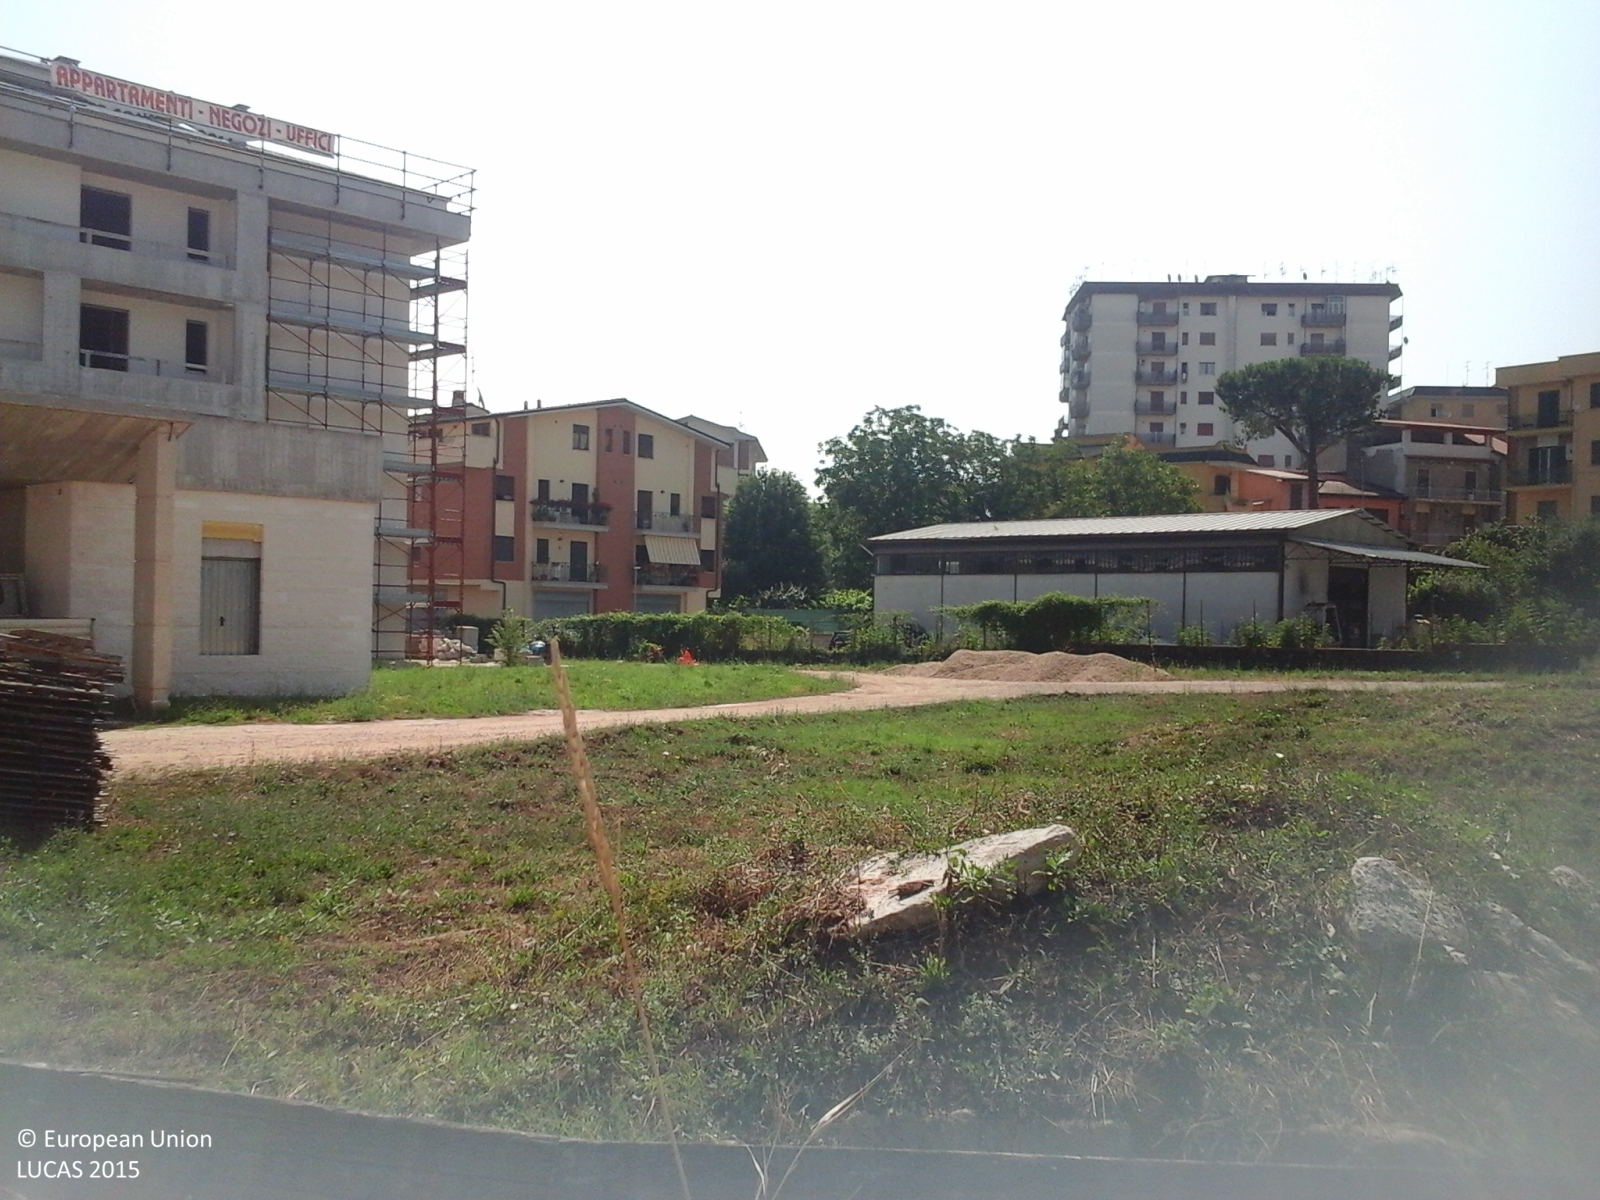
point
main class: Grassland
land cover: Grassland without tree/shrub cover
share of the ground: 10 - 25 %
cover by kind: herbaceous plants 100 %
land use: Residential
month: July
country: IT
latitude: 41.7444
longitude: 12.9110
